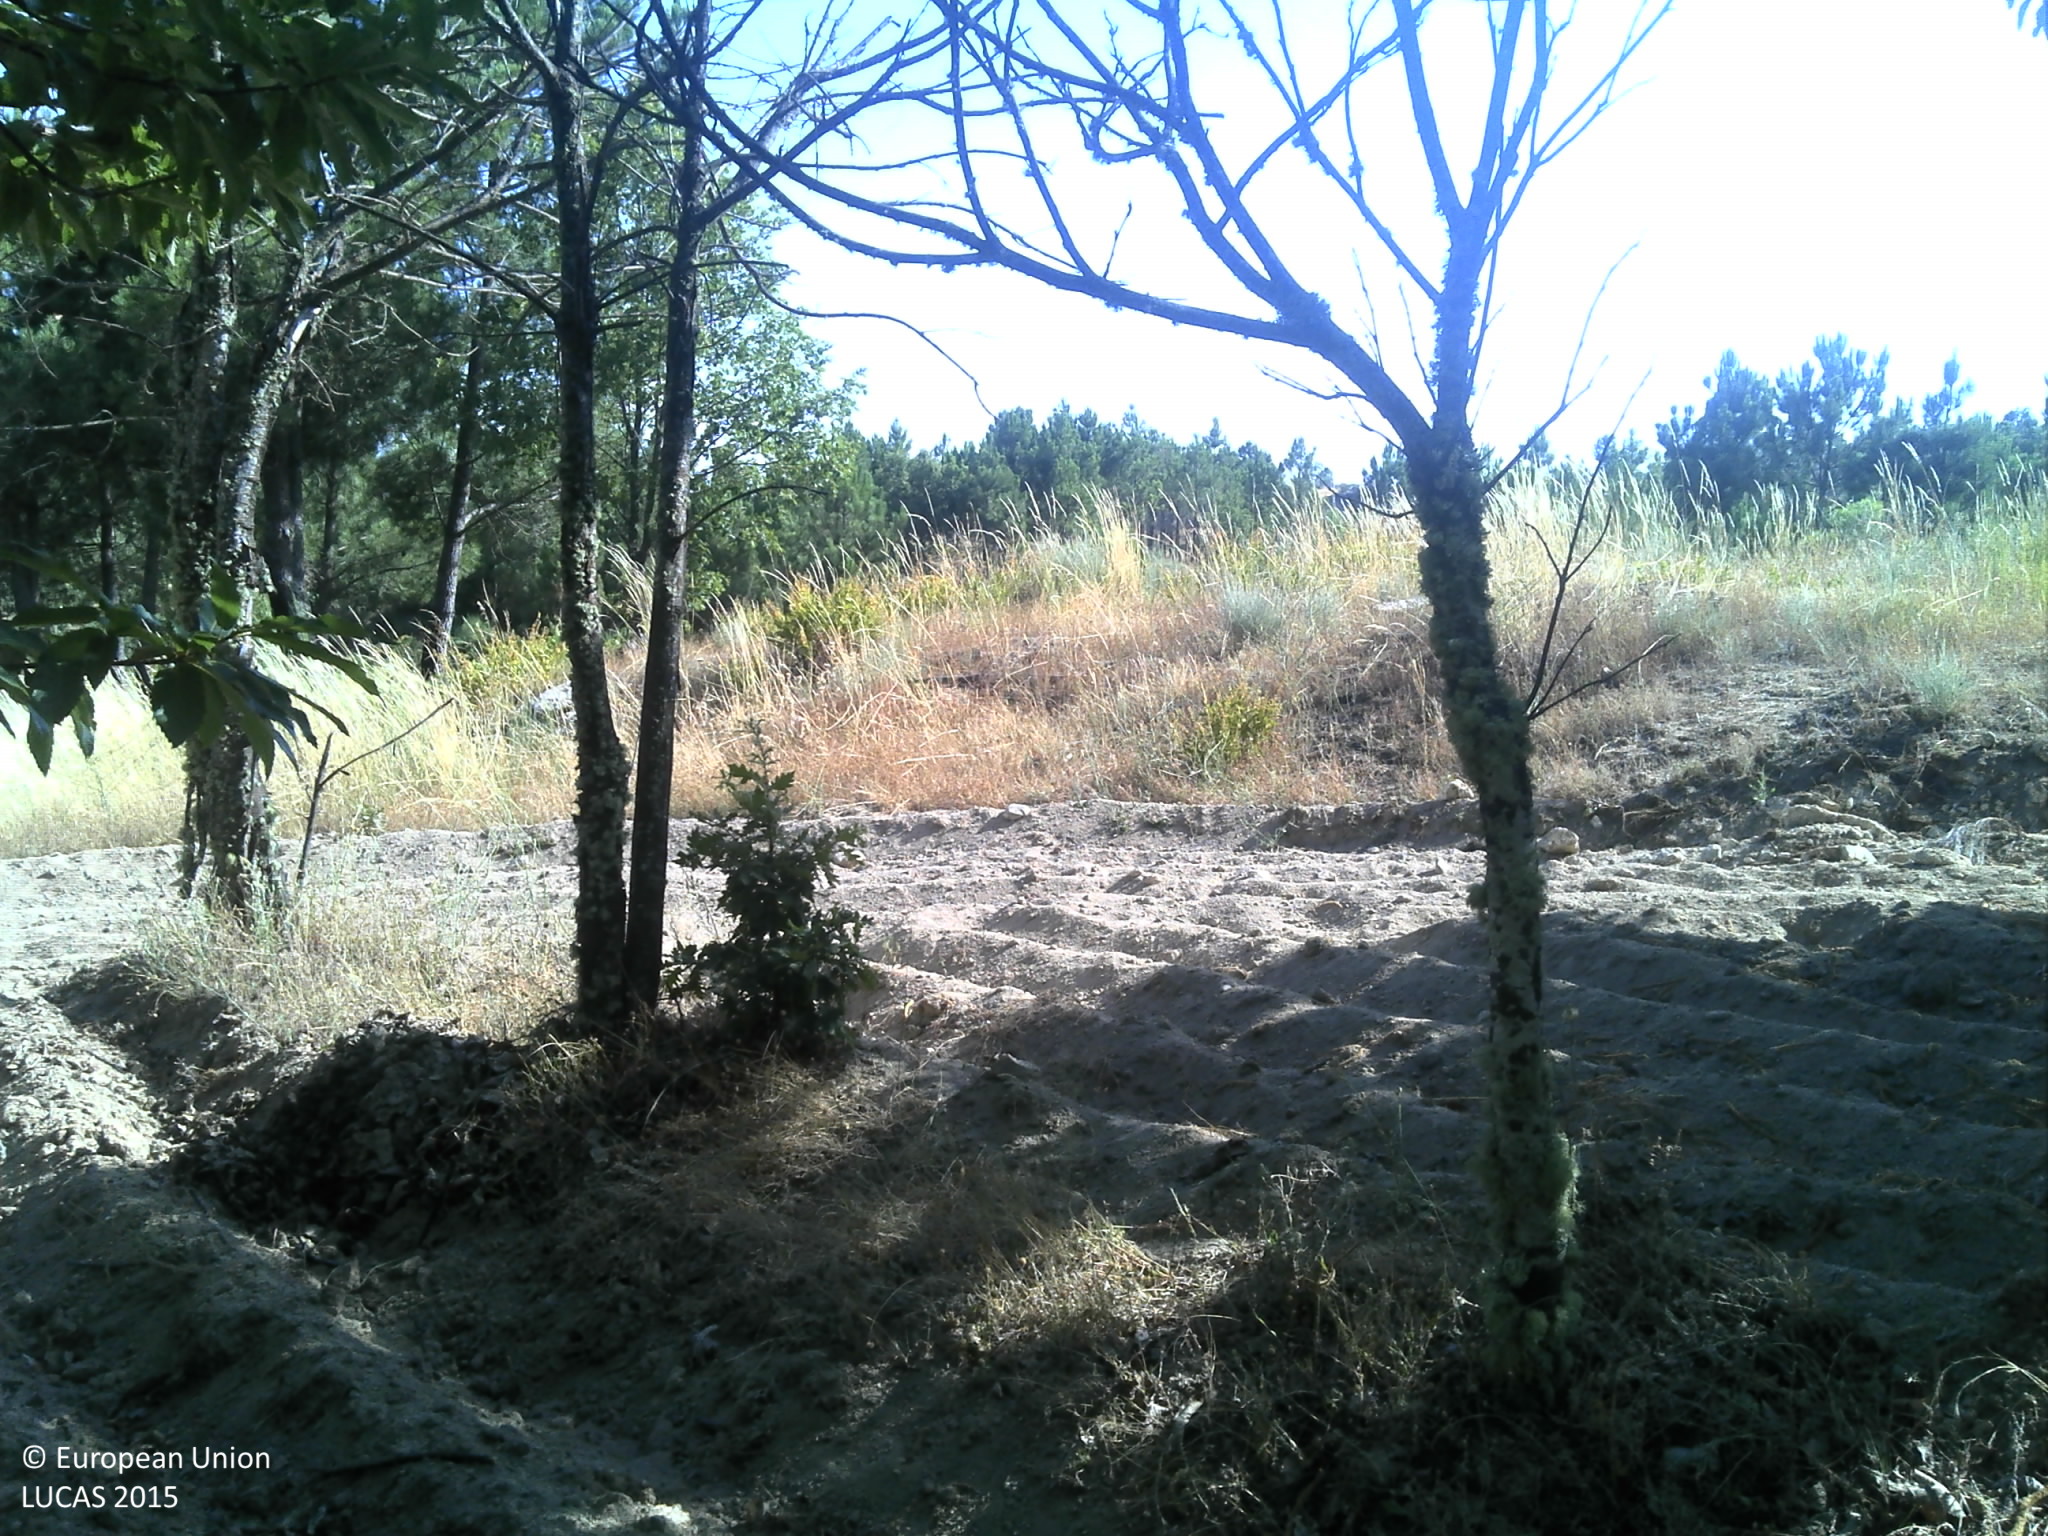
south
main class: Cropland
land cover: Nuts trees
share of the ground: 50 - 75 %
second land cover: Other bare soil
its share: > 75 %
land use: Agriculture (excluding fallow land and kitchen gardens)
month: July
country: PT
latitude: 40.8527
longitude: -7.3244
